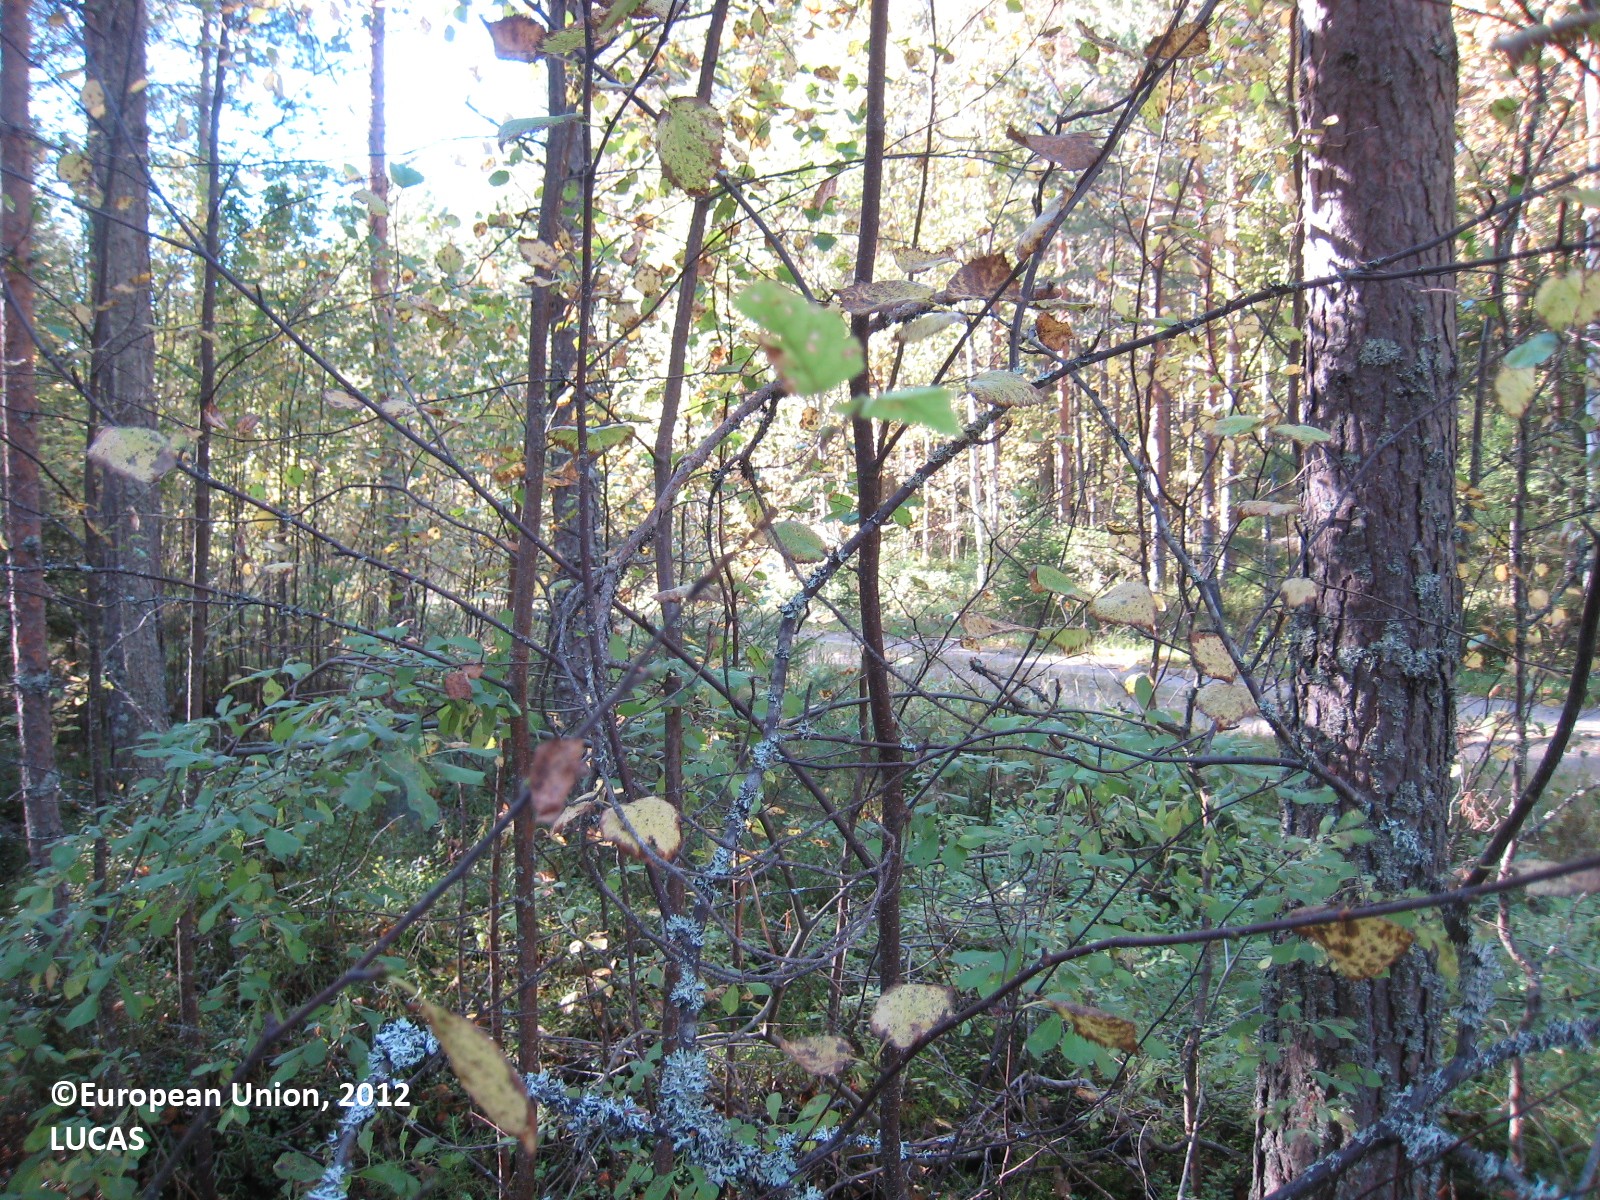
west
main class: Woodland
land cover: Pine dominated mixed woodland
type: boreal forest
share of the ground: > 75 %
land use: Forestry
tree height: > 5 m
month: September
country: FI
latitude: 62.8453
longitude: 26.6149
